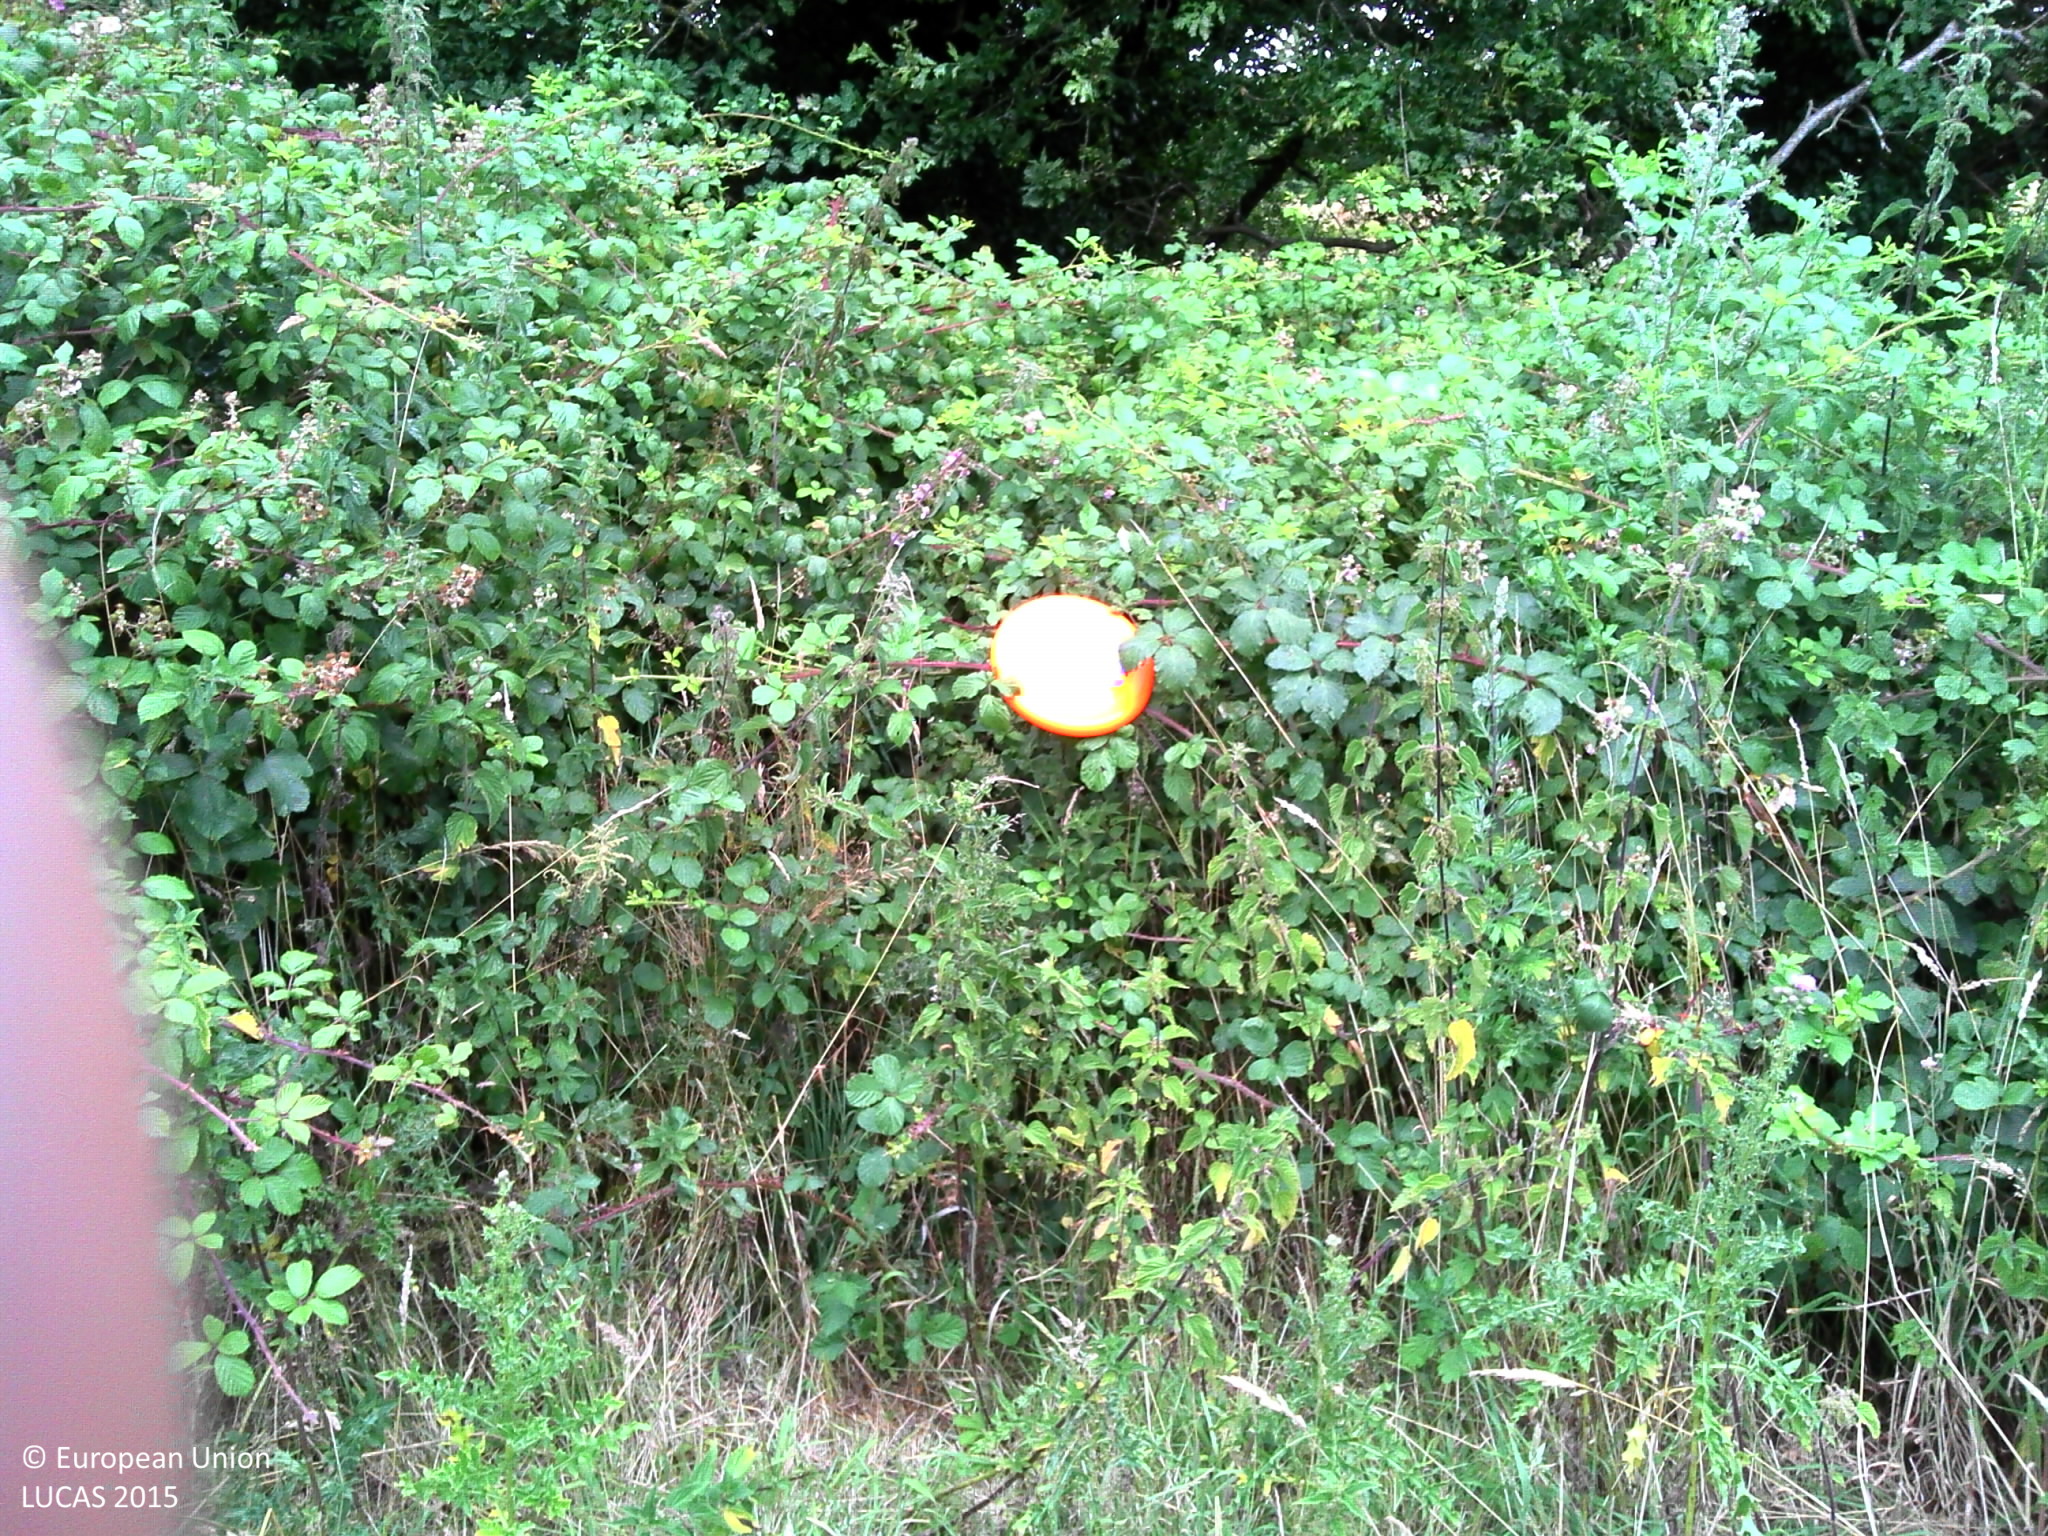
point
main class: Woodland
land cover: Broadleaved woodland
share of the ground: > 75 %
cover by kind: broadleaved forest trees 50 %, shrubs 30 %, herbaceous plants 10 %, consolidated bare surface 10 %
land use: Forestry
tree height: < 5 m
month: July
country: FR
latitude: 47.7141
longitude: -3.2262
